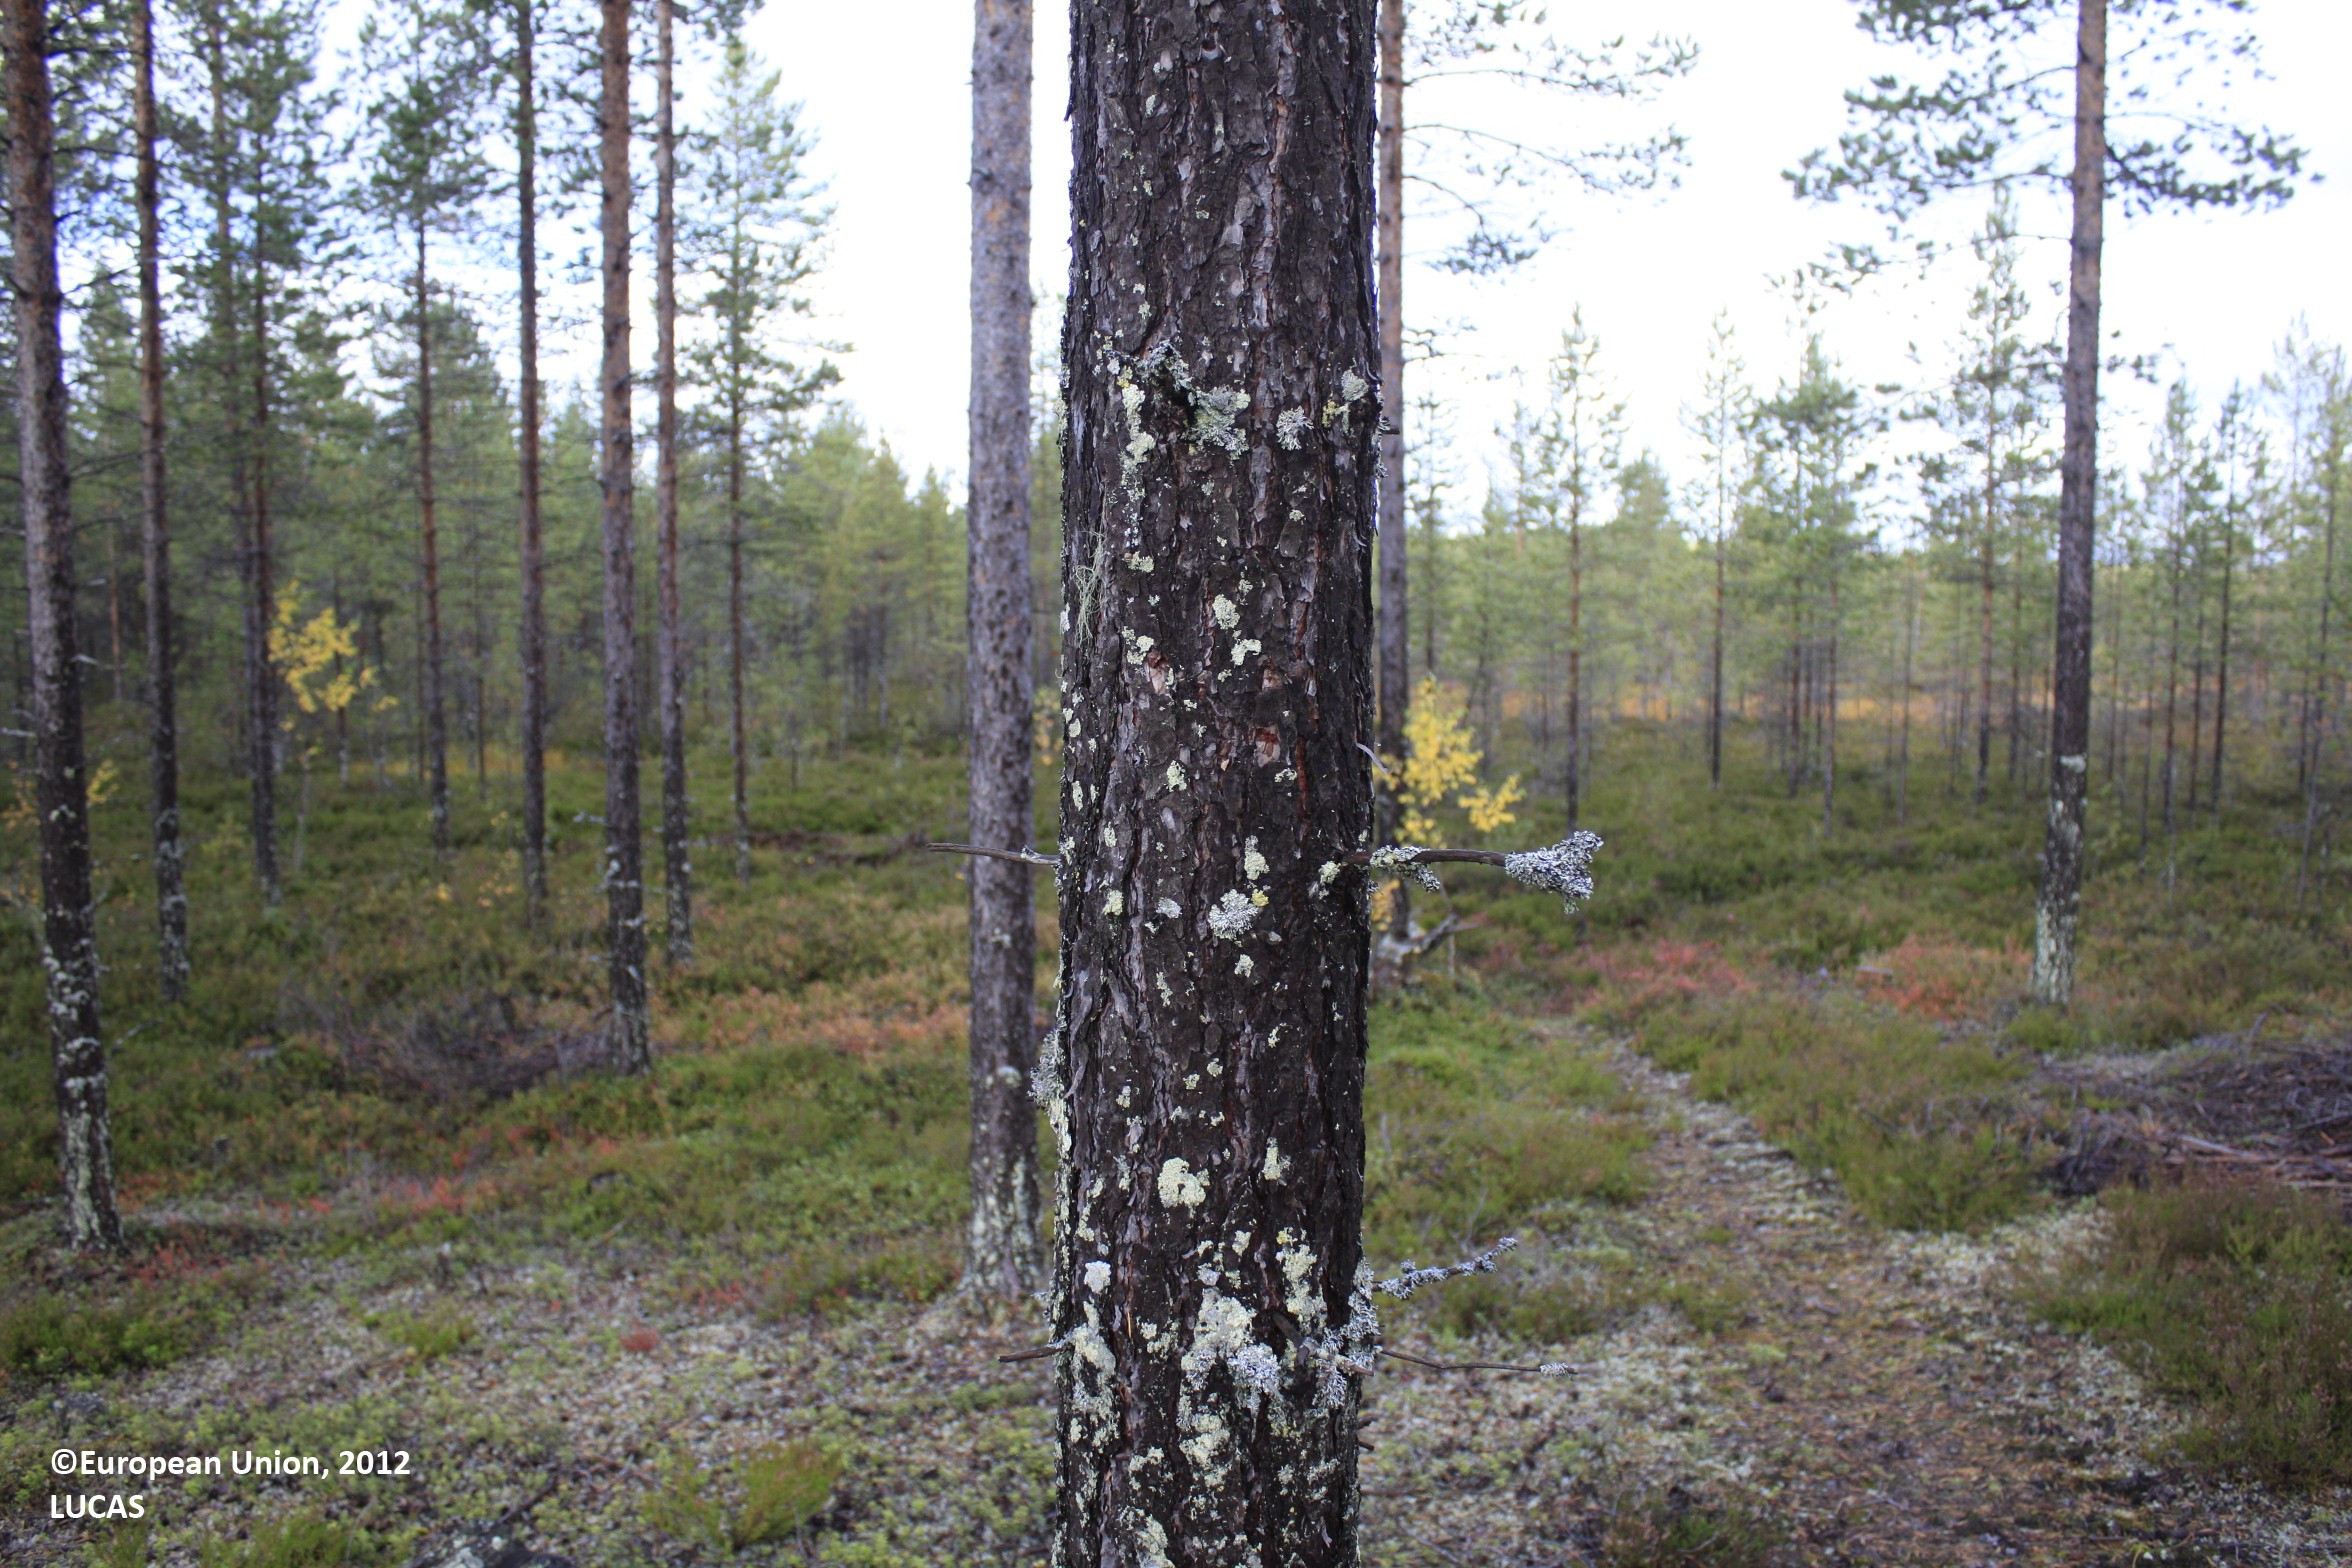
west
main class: Woodland
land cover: Pine dominated coniferous woodland
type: boreal forest
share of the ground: 25 - 50 %
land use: Forestry
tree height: > 5 m
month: September
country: FI
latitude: 65.5710
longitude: 27.3516
